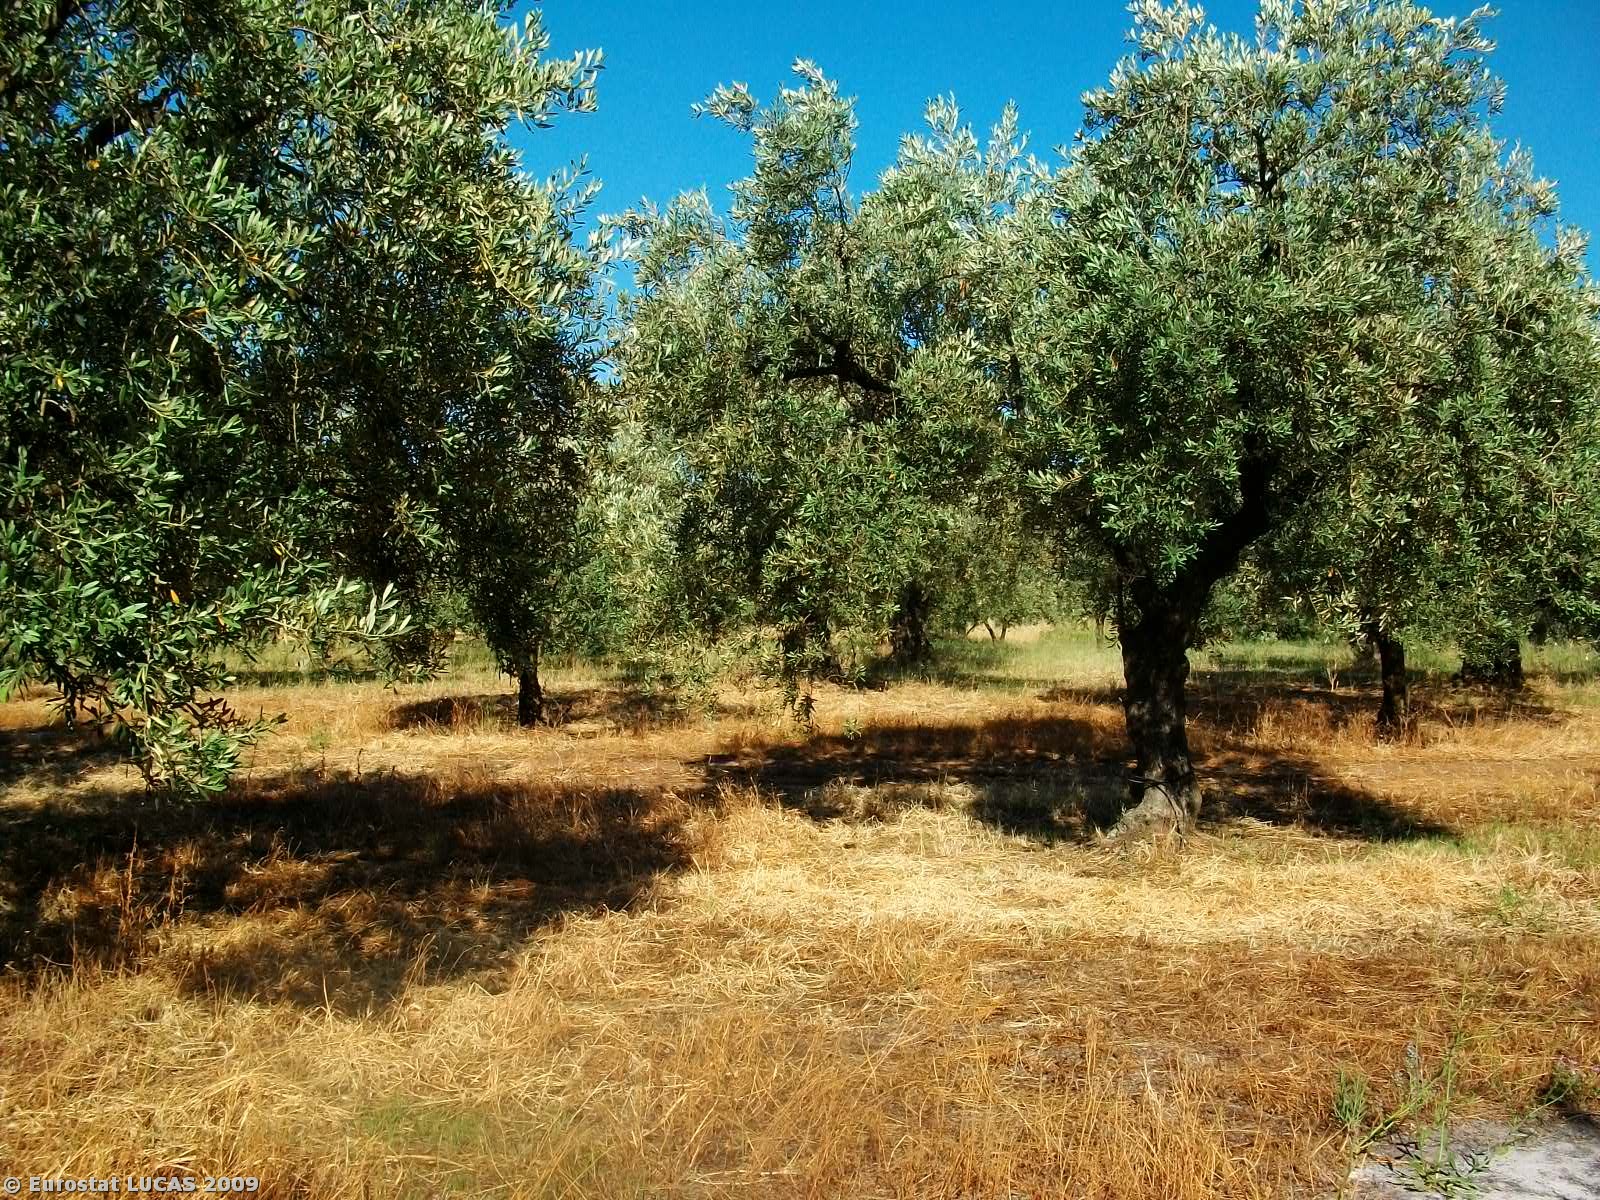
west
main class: Cropland
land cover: Olive groves
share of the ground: > 75 %
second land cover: Grassland with sparse tree/shrub cover
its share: > 75 %
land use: Agriculture (excluding fallow land and kitchen gardens)
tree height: < 5 m
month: June
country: GR
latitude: 38.8895
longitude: 22.6991
